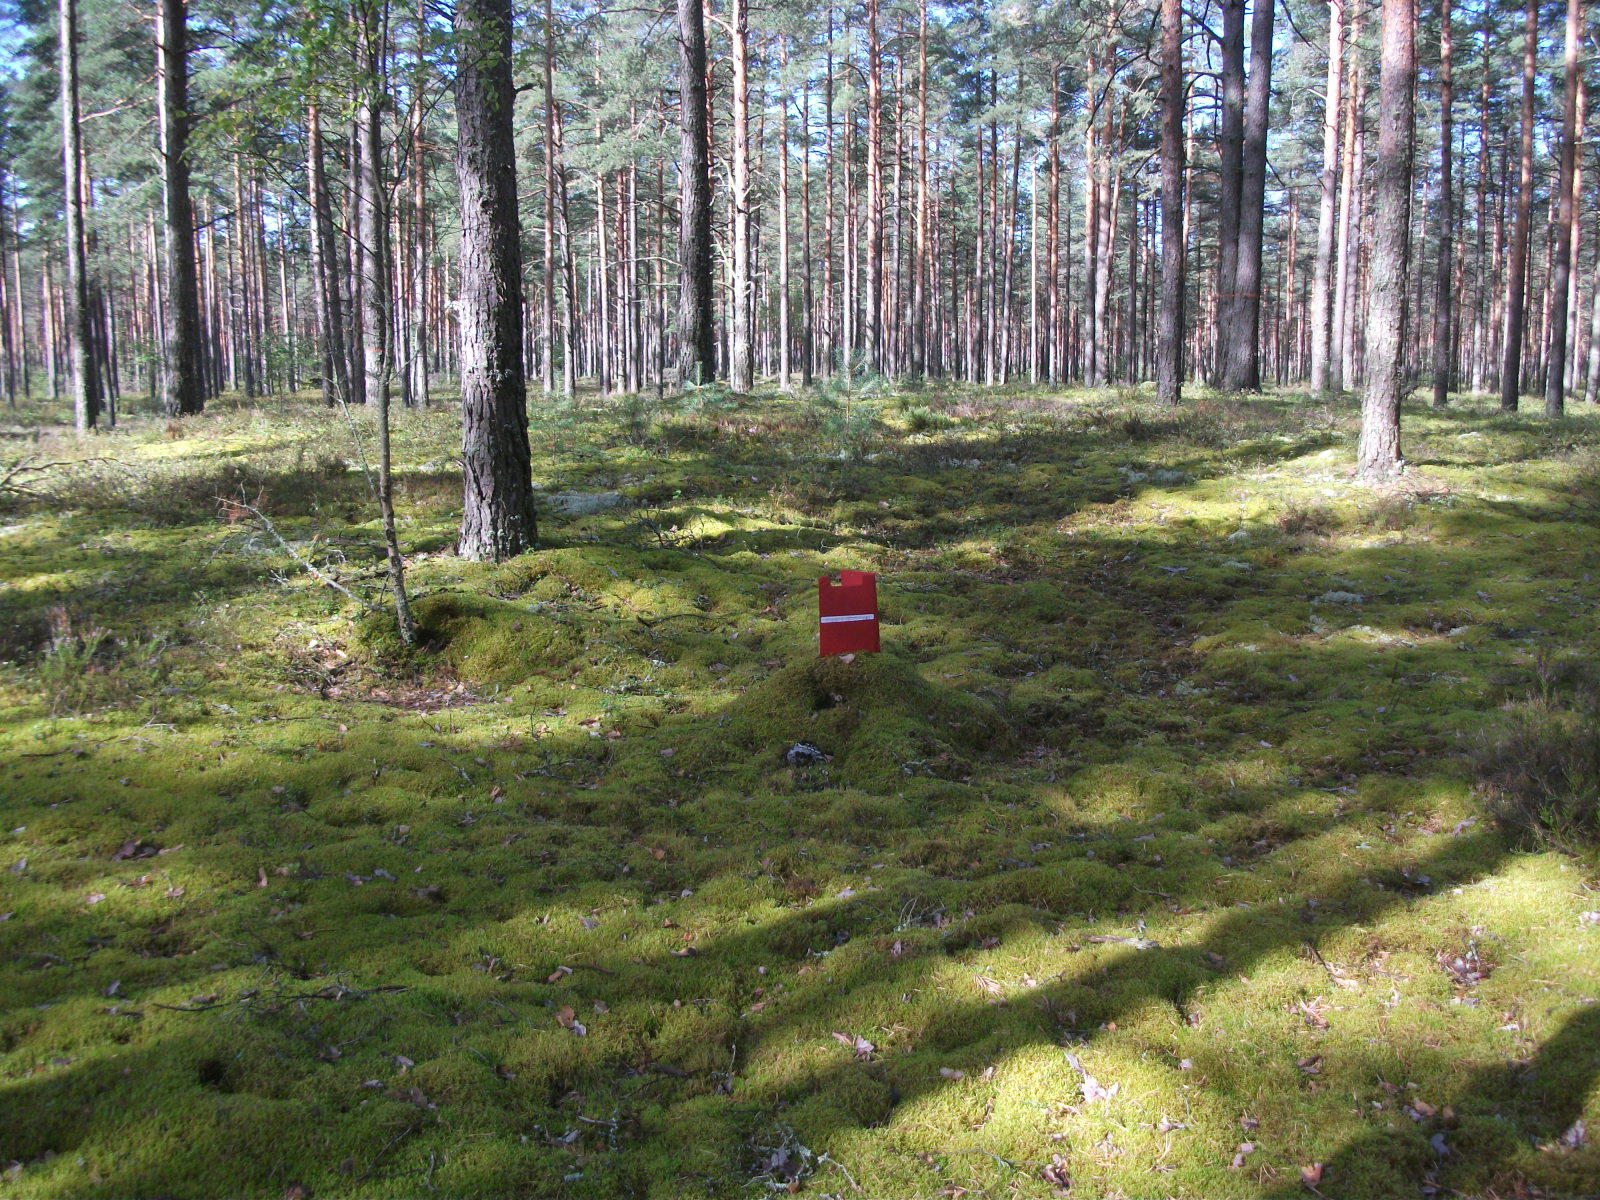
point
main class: Woodland
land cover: Pine dominated coniferous woodland
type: hemiboreal forest and nemoral coniferous forest and mixed broadleaved-coniferous forest
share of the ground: 50 - 75 %
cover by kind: coniferous forest trees 65 %, lichens and mosses 35 %
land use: Forestry
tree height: > 5 m
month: August
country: LV
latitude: 56.5058
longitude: 26.5097
